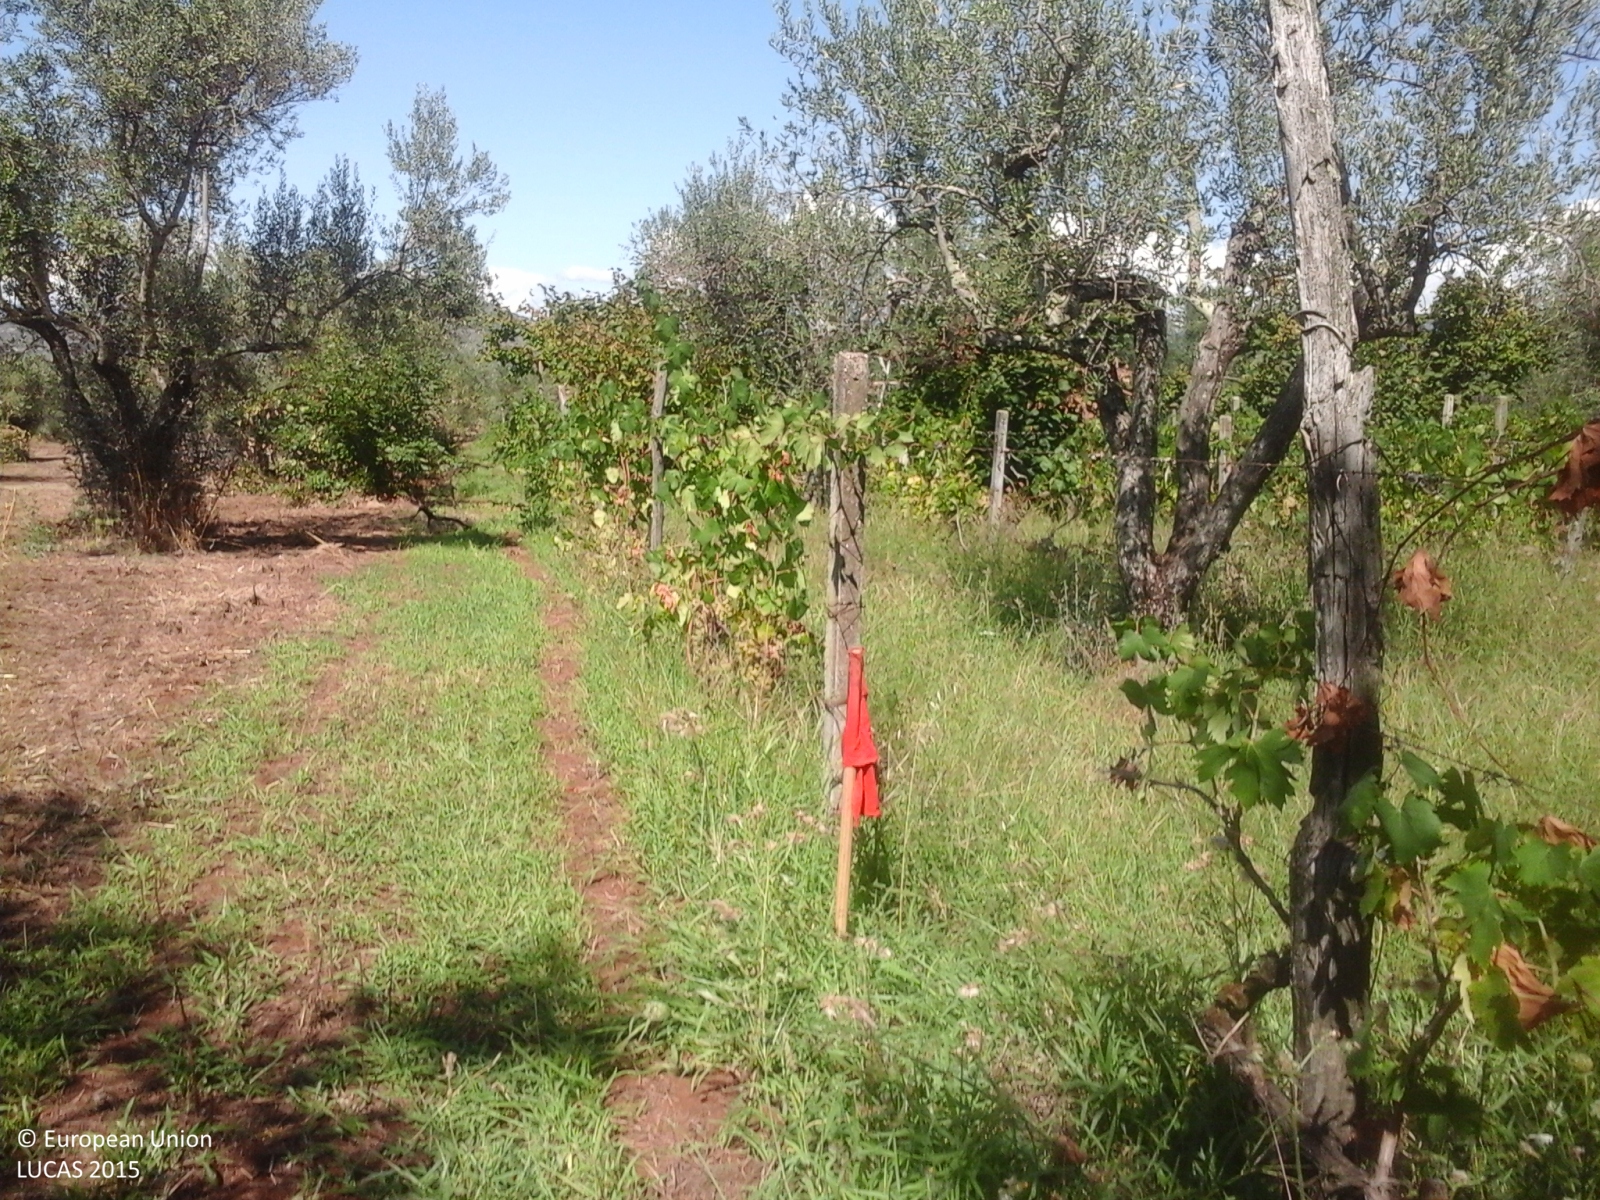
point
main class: Cropland
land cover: Vineyards
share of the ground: 50 - 75 %
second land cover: Olive groves
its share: 50 - 75 %
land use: Agriculture (excluding fallow land and kitchen gardens)
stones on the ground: < 10 %
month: August
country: IT
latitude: 41.8923
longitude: 12.7979
